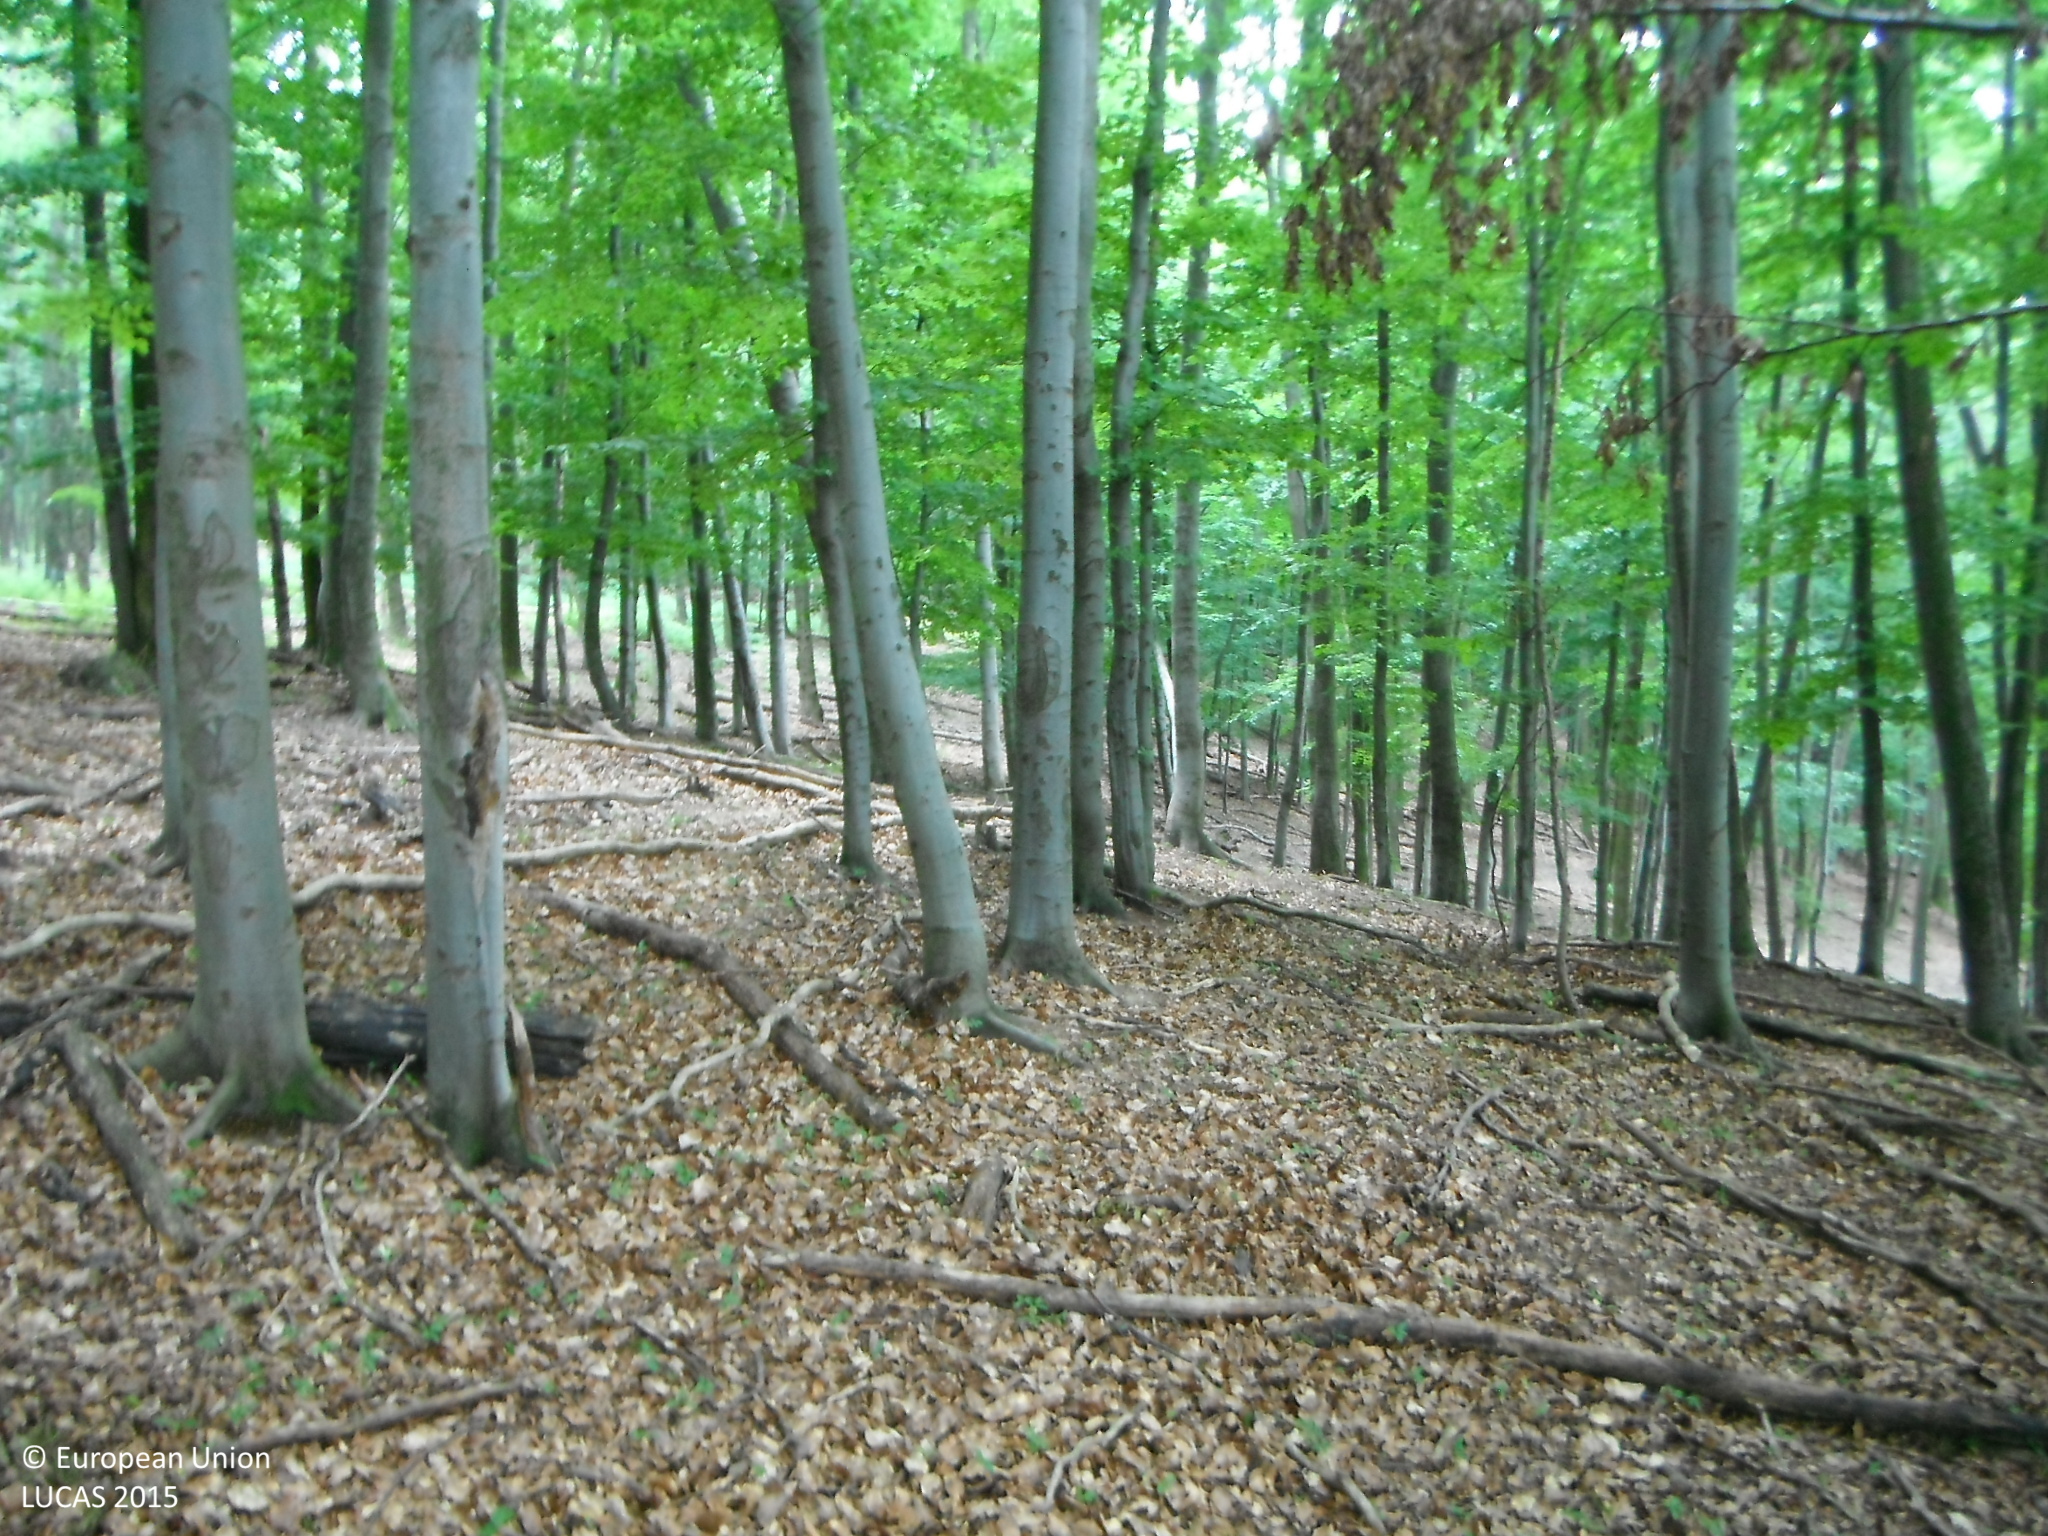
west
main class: Woodland
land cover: Broadleaved woodland
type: beech forest
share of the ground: > 75 %
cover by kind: broadleaved forest trees 100 %
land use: Forestry
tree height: > 5 m
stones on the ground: < 10 %
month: June
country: SK
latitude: 48.4459
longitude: 17.3779
